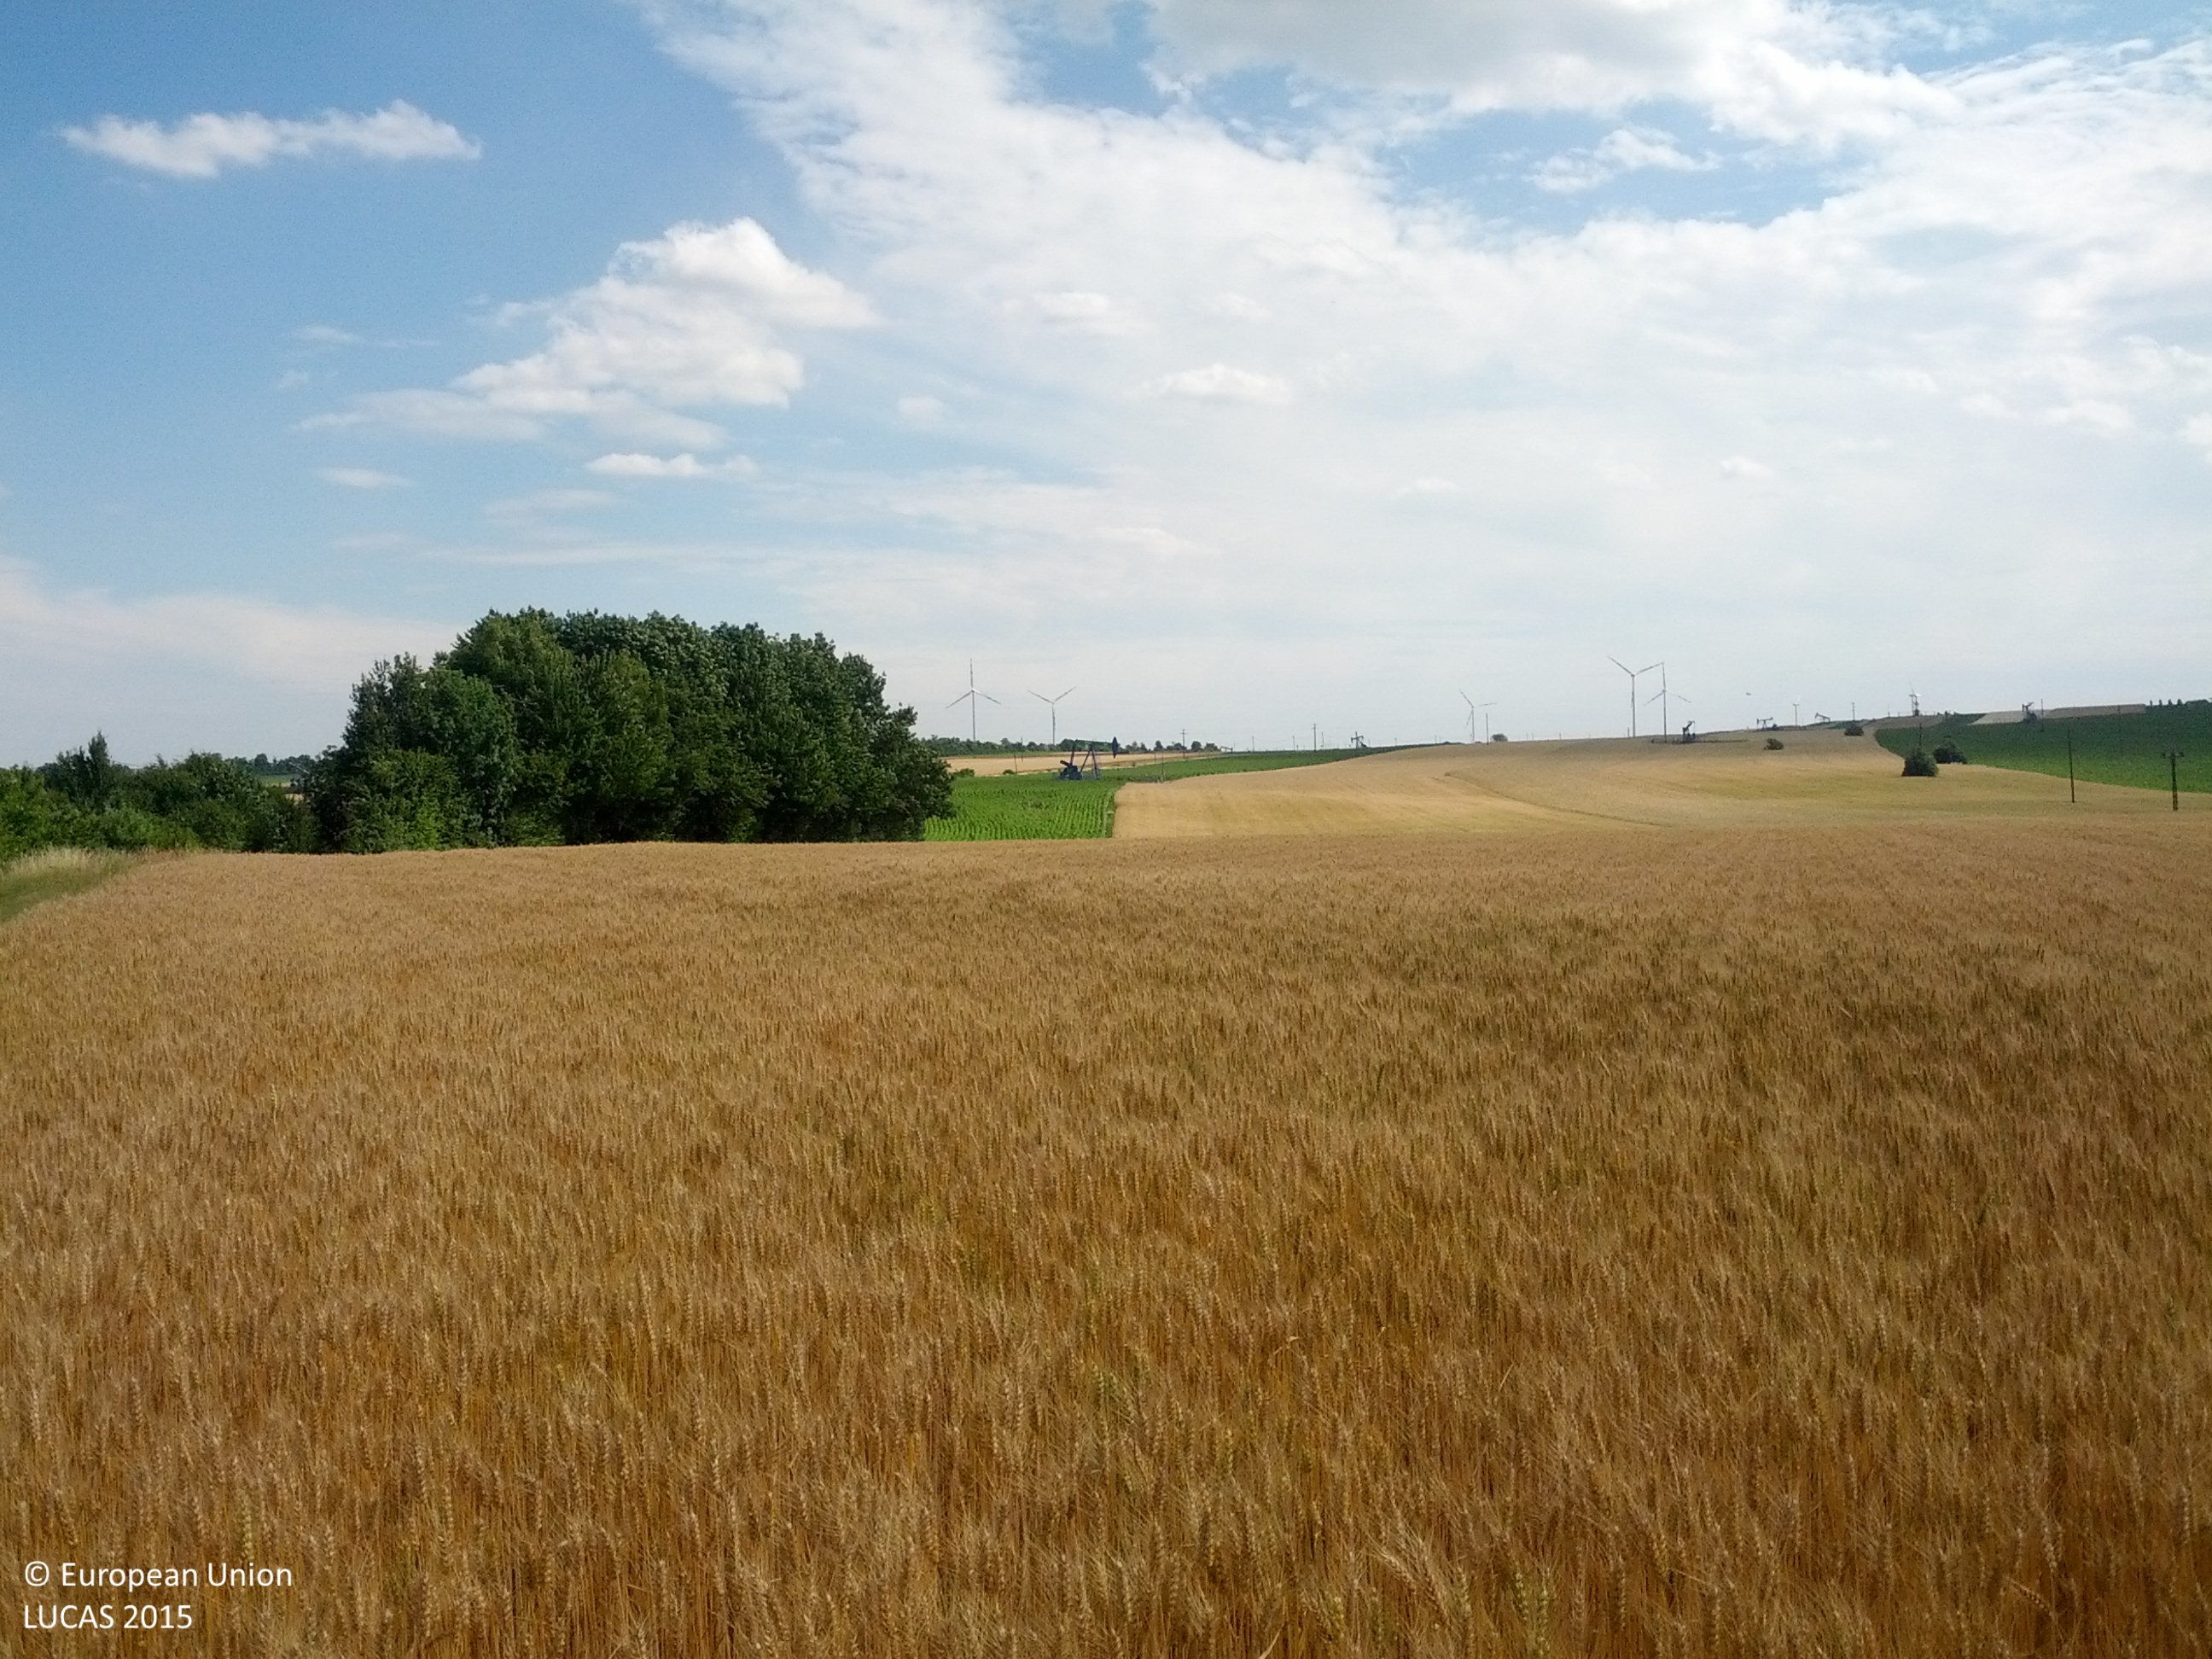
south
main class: Cropland
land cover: Common wheat
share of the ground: > 75 %
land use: Agriculture (excluding fallow land and kitchen gardens)
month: June
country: AT
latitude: 48.3830
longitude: 16.6633
